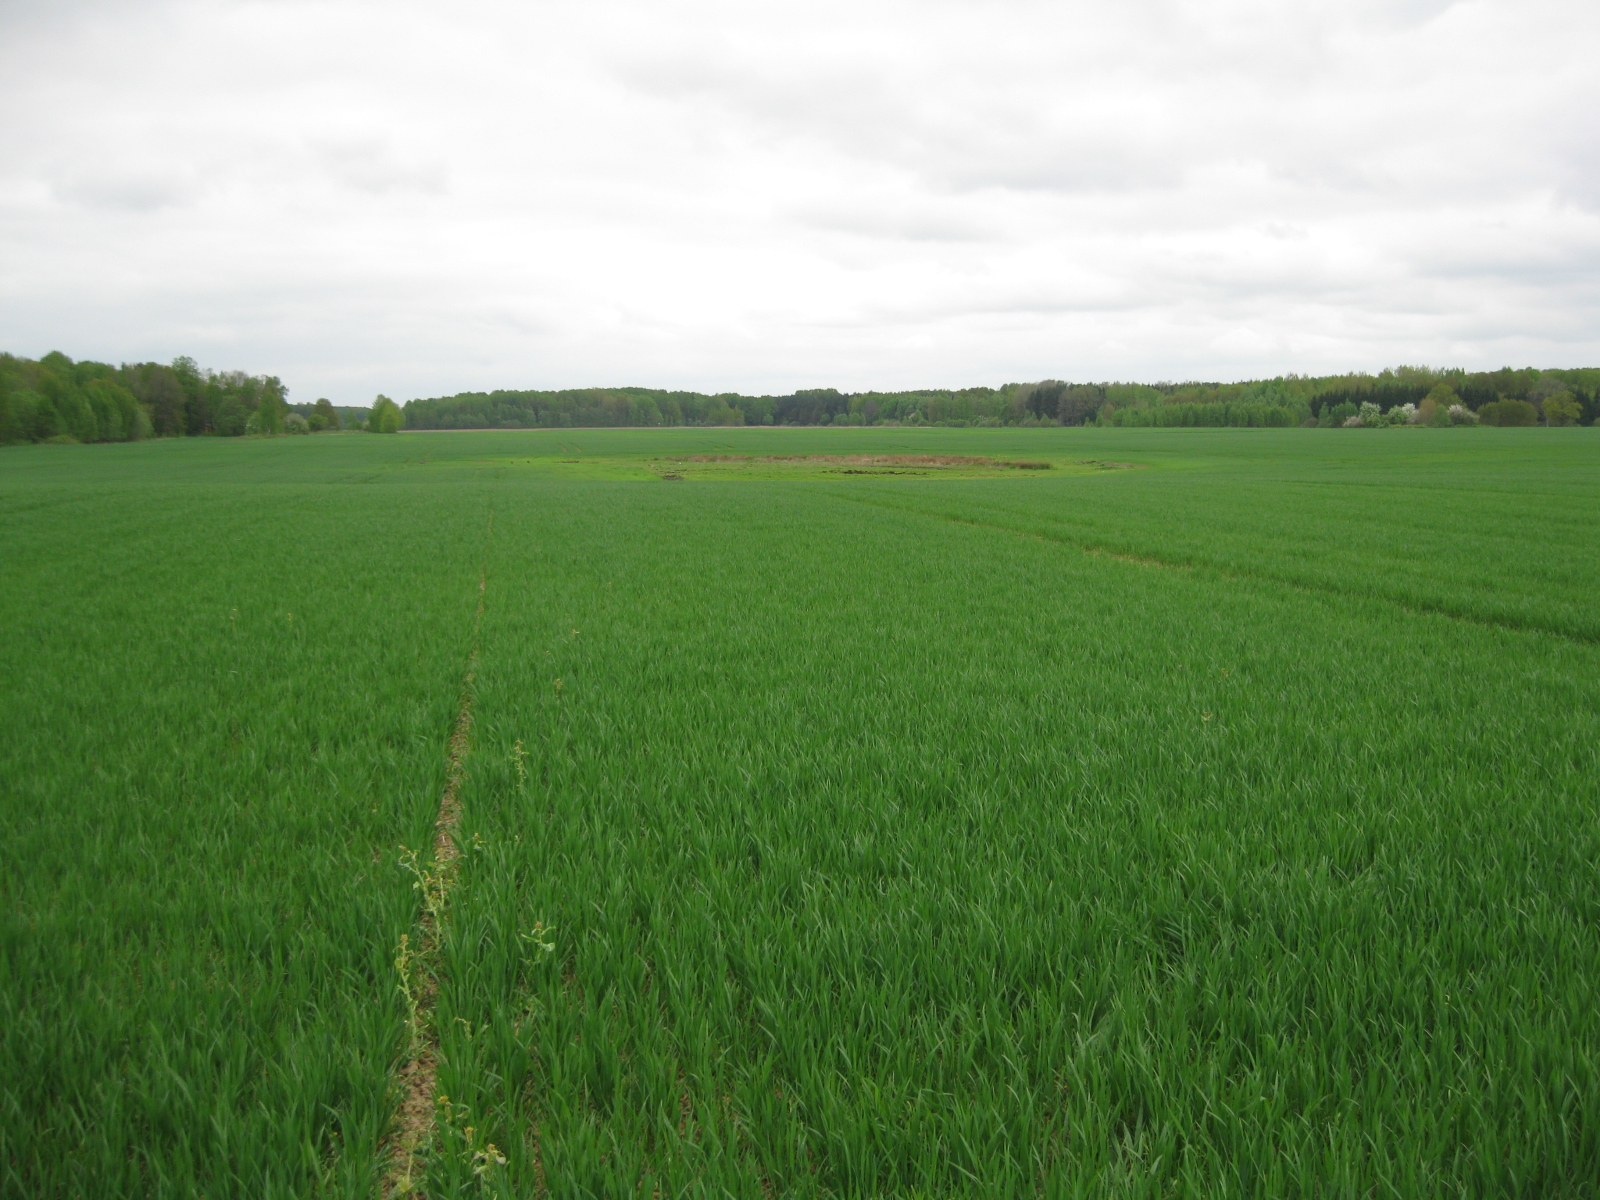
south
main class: Cropland
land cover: Common wheat
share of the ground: > 75 %
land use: Agriculture (excluding fallow land and kitchen gardens)
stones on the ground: < 10 %
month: May
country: LT
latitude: 56.0079
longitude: 24.4182
